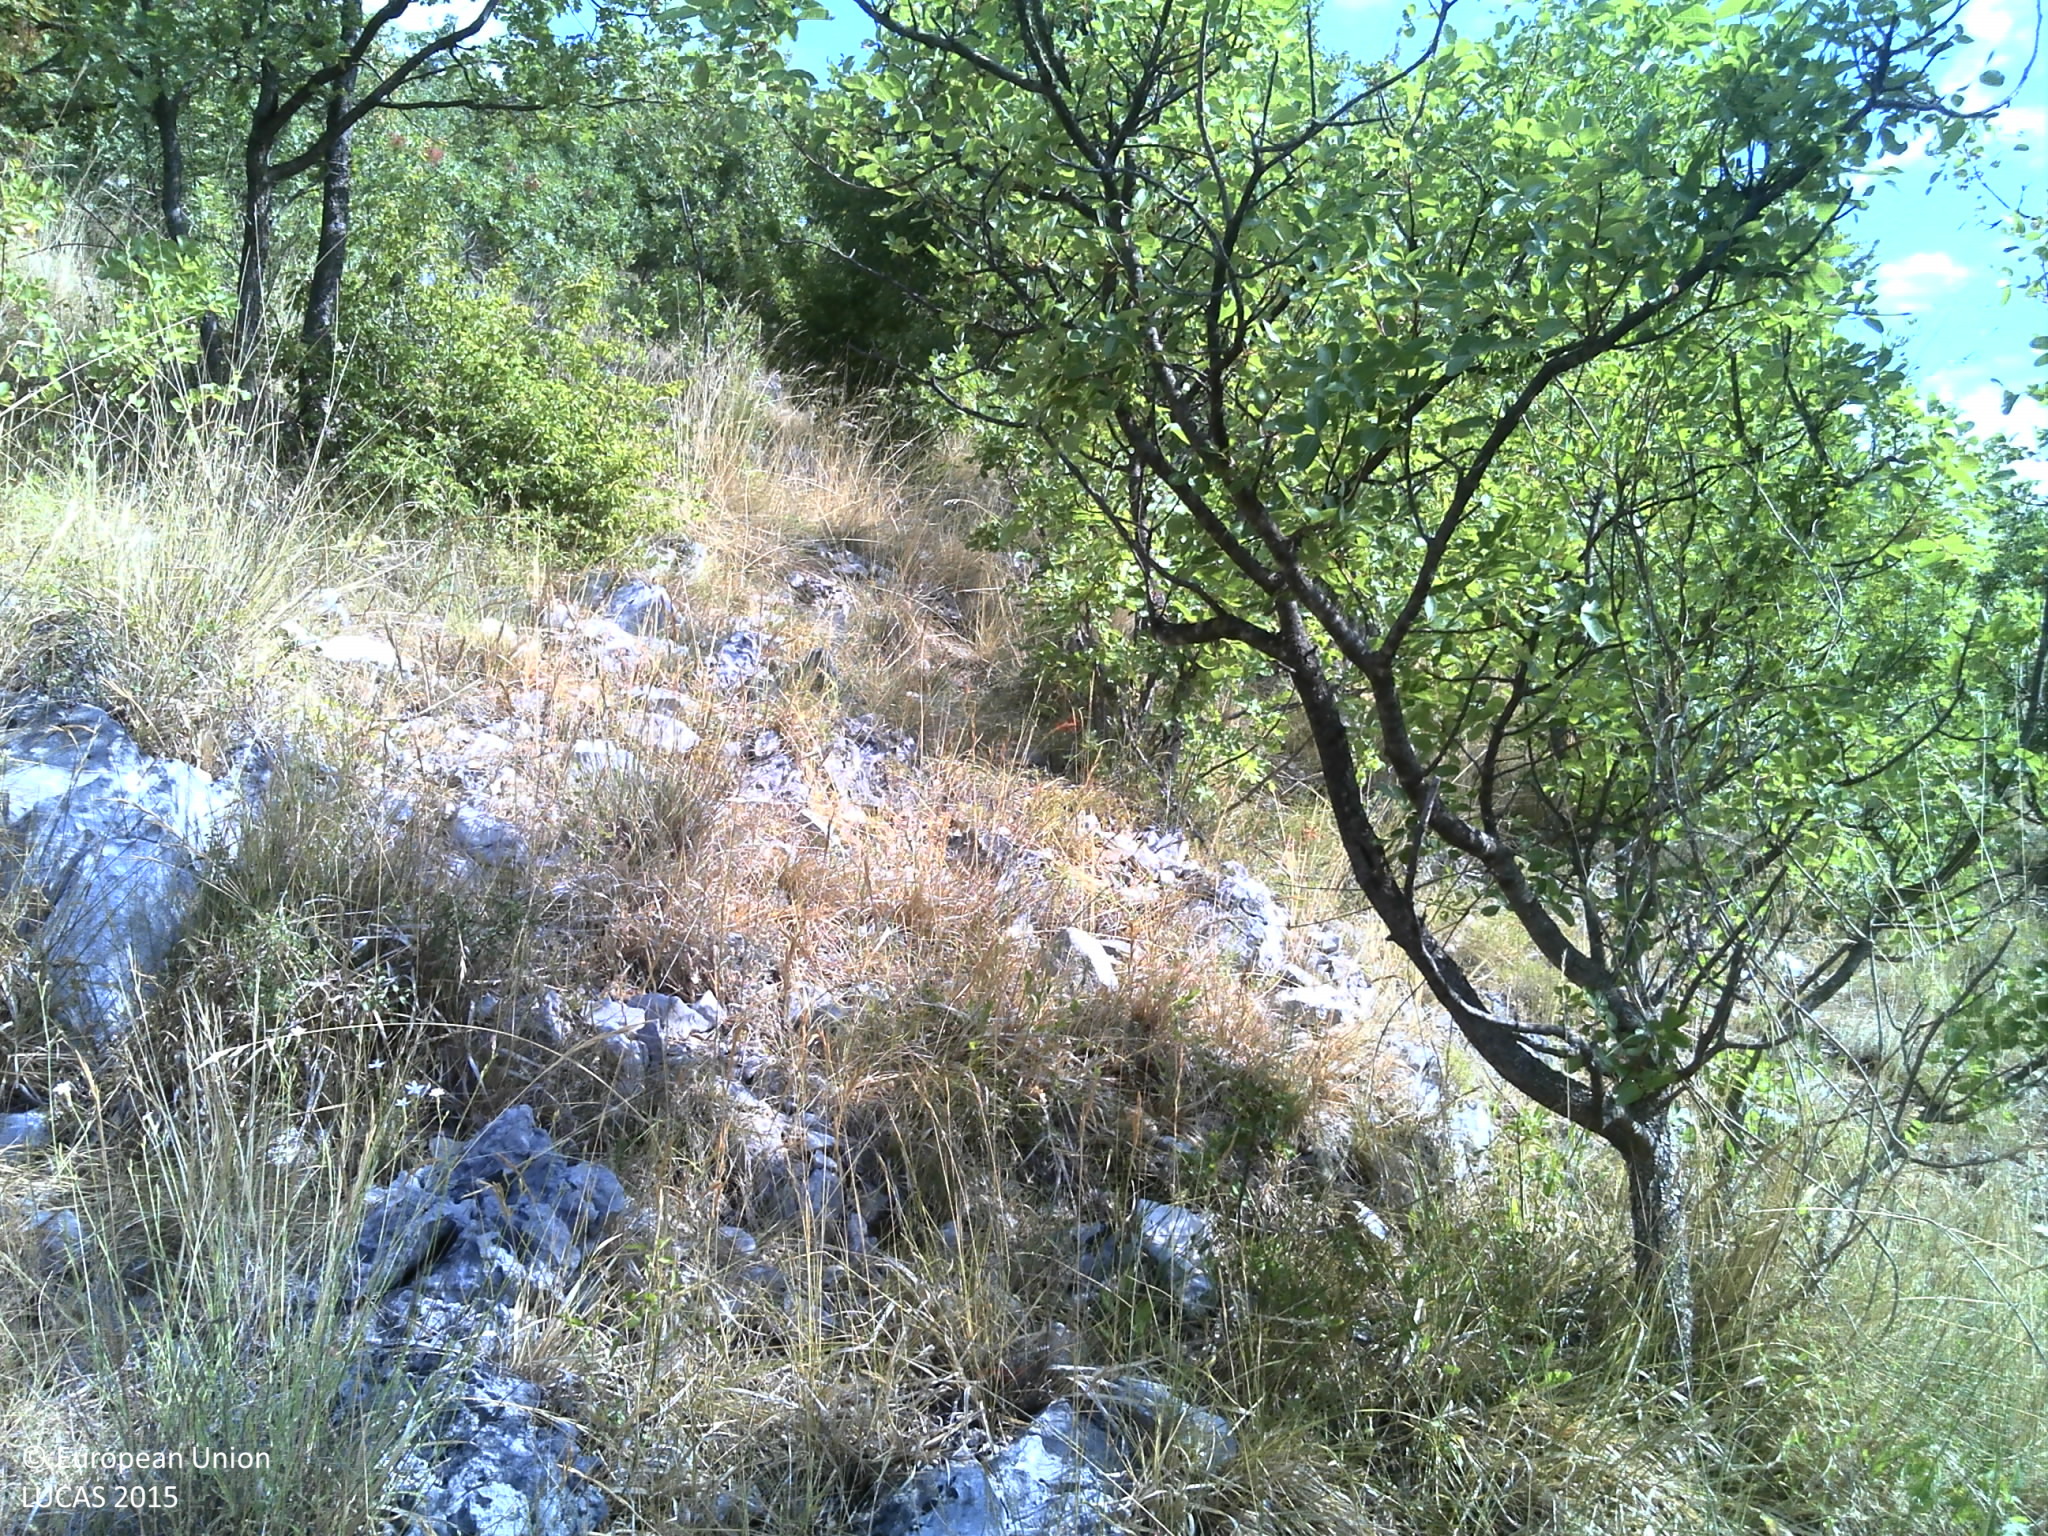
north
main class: Shrubland
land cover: Shrubland with sparse tree cover
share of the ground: 50 - 75 %
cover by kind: shrubs 60 %, consolidated bare surface 15 %, herbaceous plants 10 %, unconsolidated bare surface 10 %, broadleaved forest trees 5 %
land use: Semi-natural and natural areas not in use
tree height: < 5 m
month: July
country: HR
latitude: 43.4735
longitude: 17.1000
